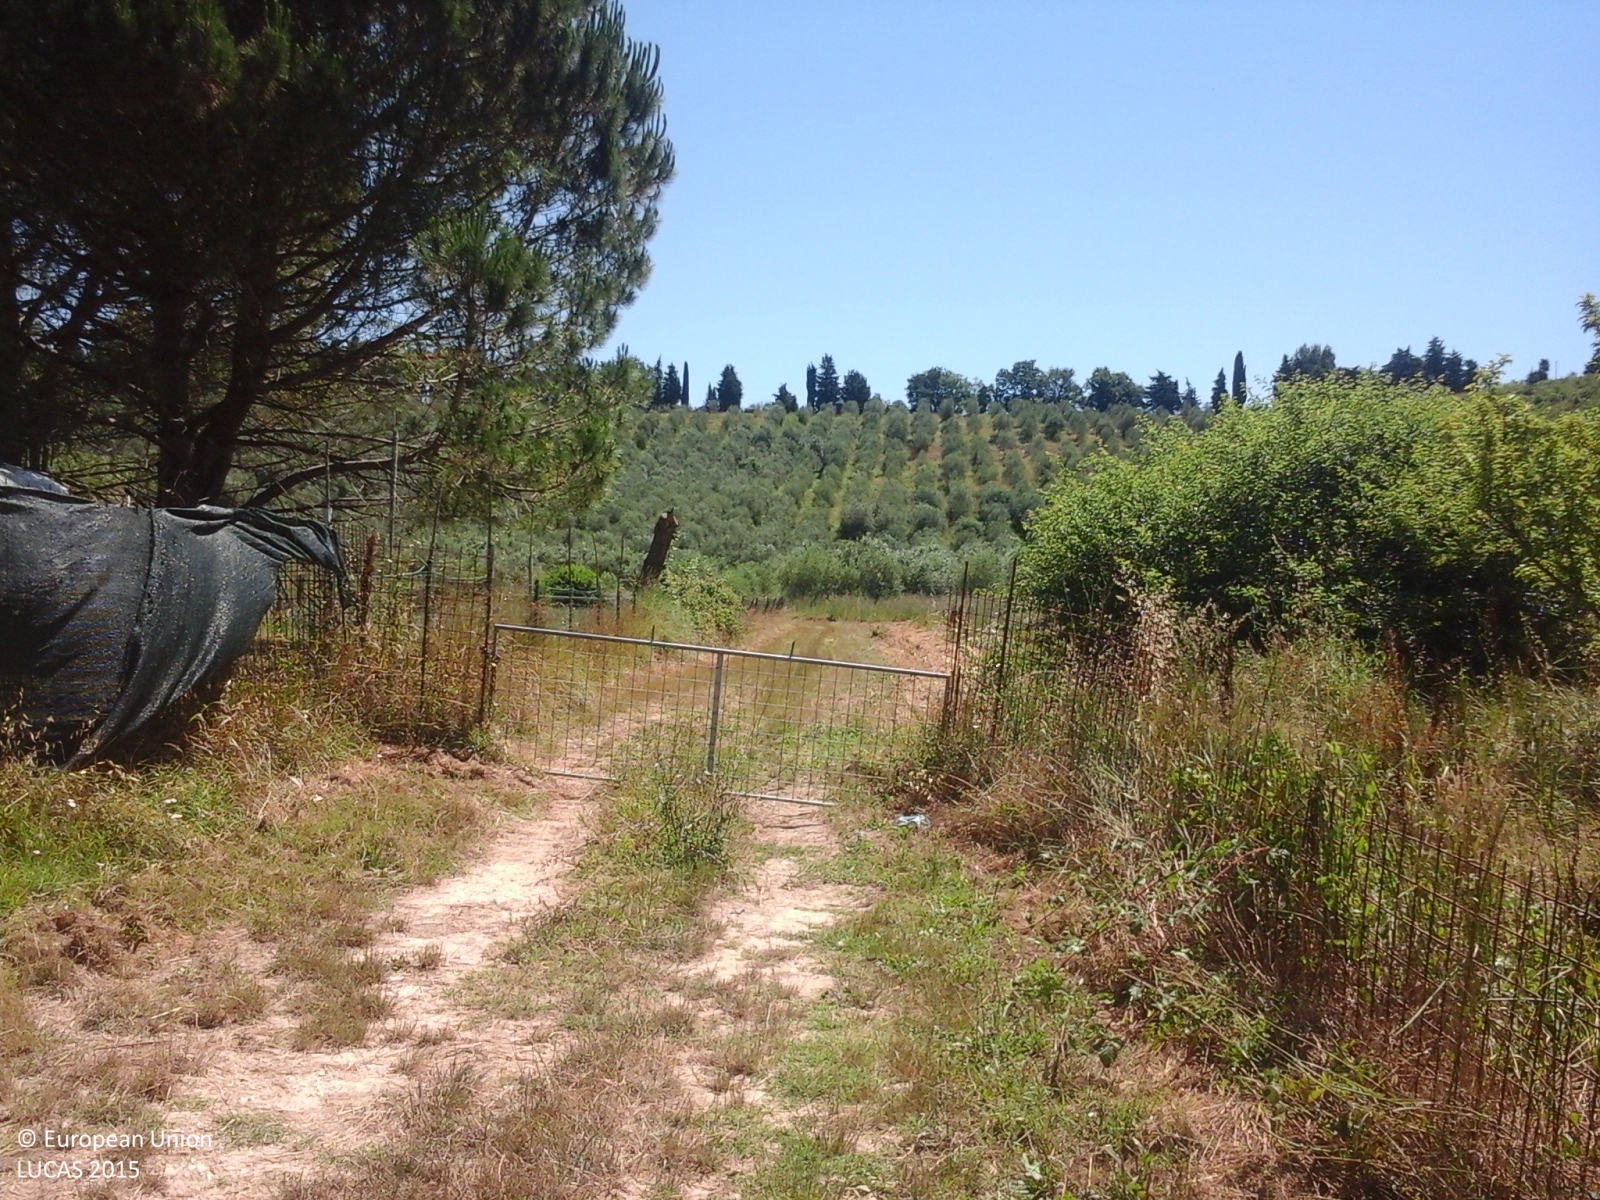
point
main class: Cropland
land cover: Olive groves
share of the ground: 50 - 75 %
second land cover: Grassland without tree/shrub cover
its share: 50 - 75 %
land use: Agriculture (excluding fallow land and kitchen gardens)
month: June
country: IT
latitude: 43.5730
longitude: 10.6051
